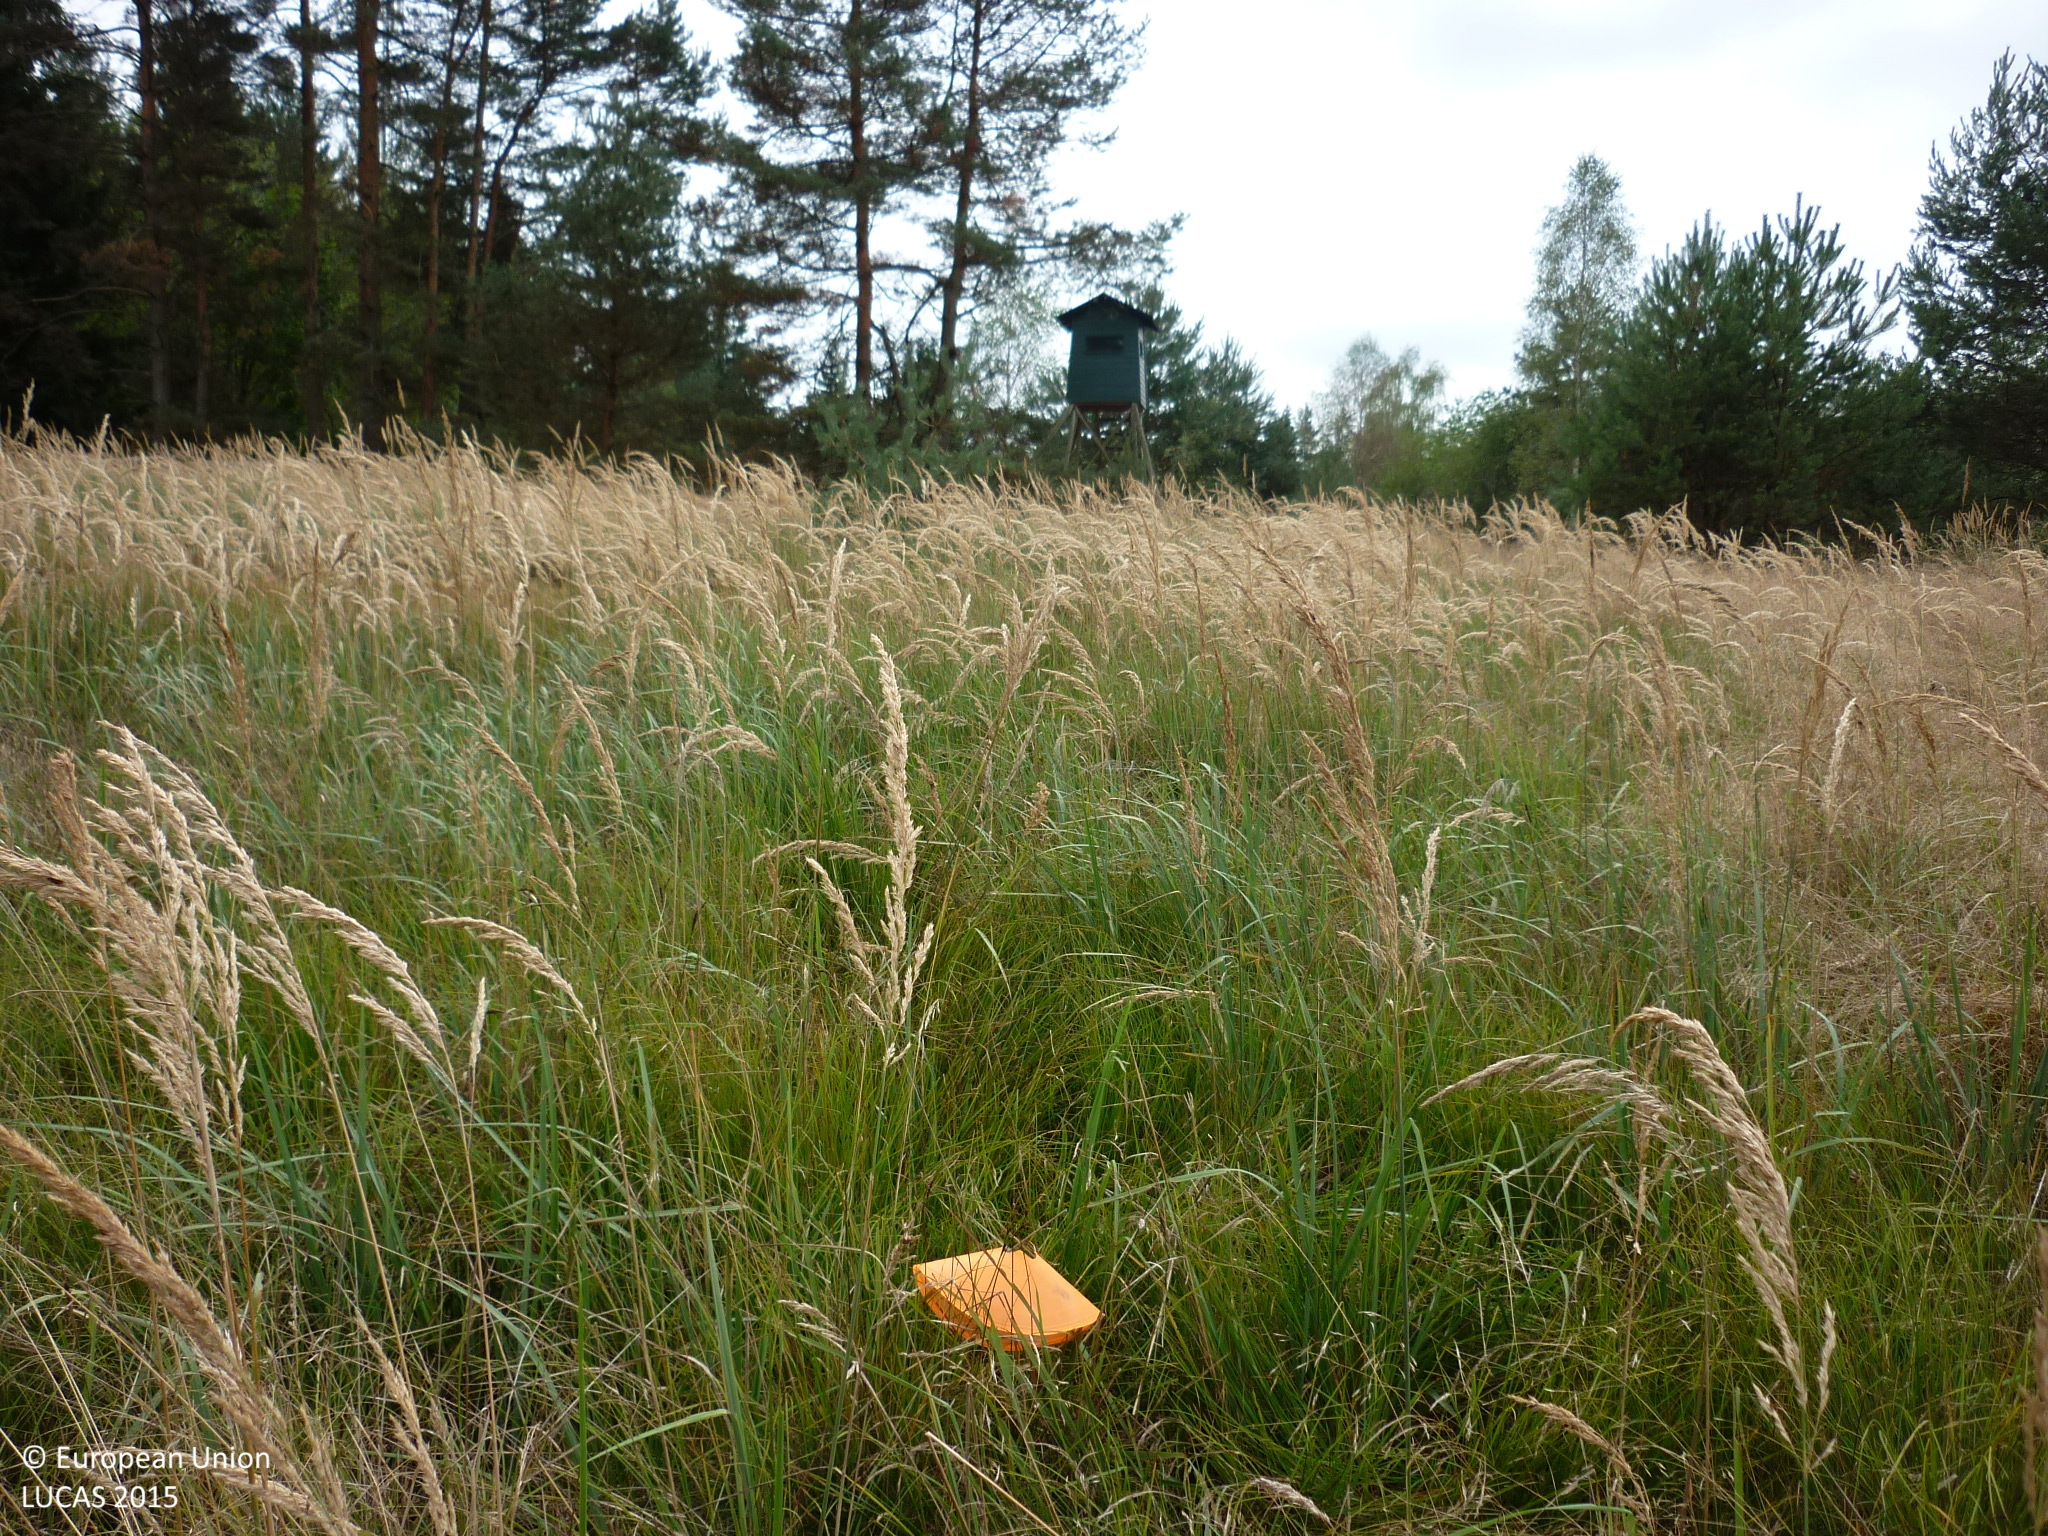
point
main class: Grassland
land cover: Grassland with sparse tree/shrub cover
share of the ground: > 75 %
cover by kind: herbaceous plants 95 %, coniferous forest trees 5 %
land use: Semi-natural and natural areas not in use
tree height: > 5 m
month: September
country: AT
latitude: 48.8491
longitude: 15.0033
